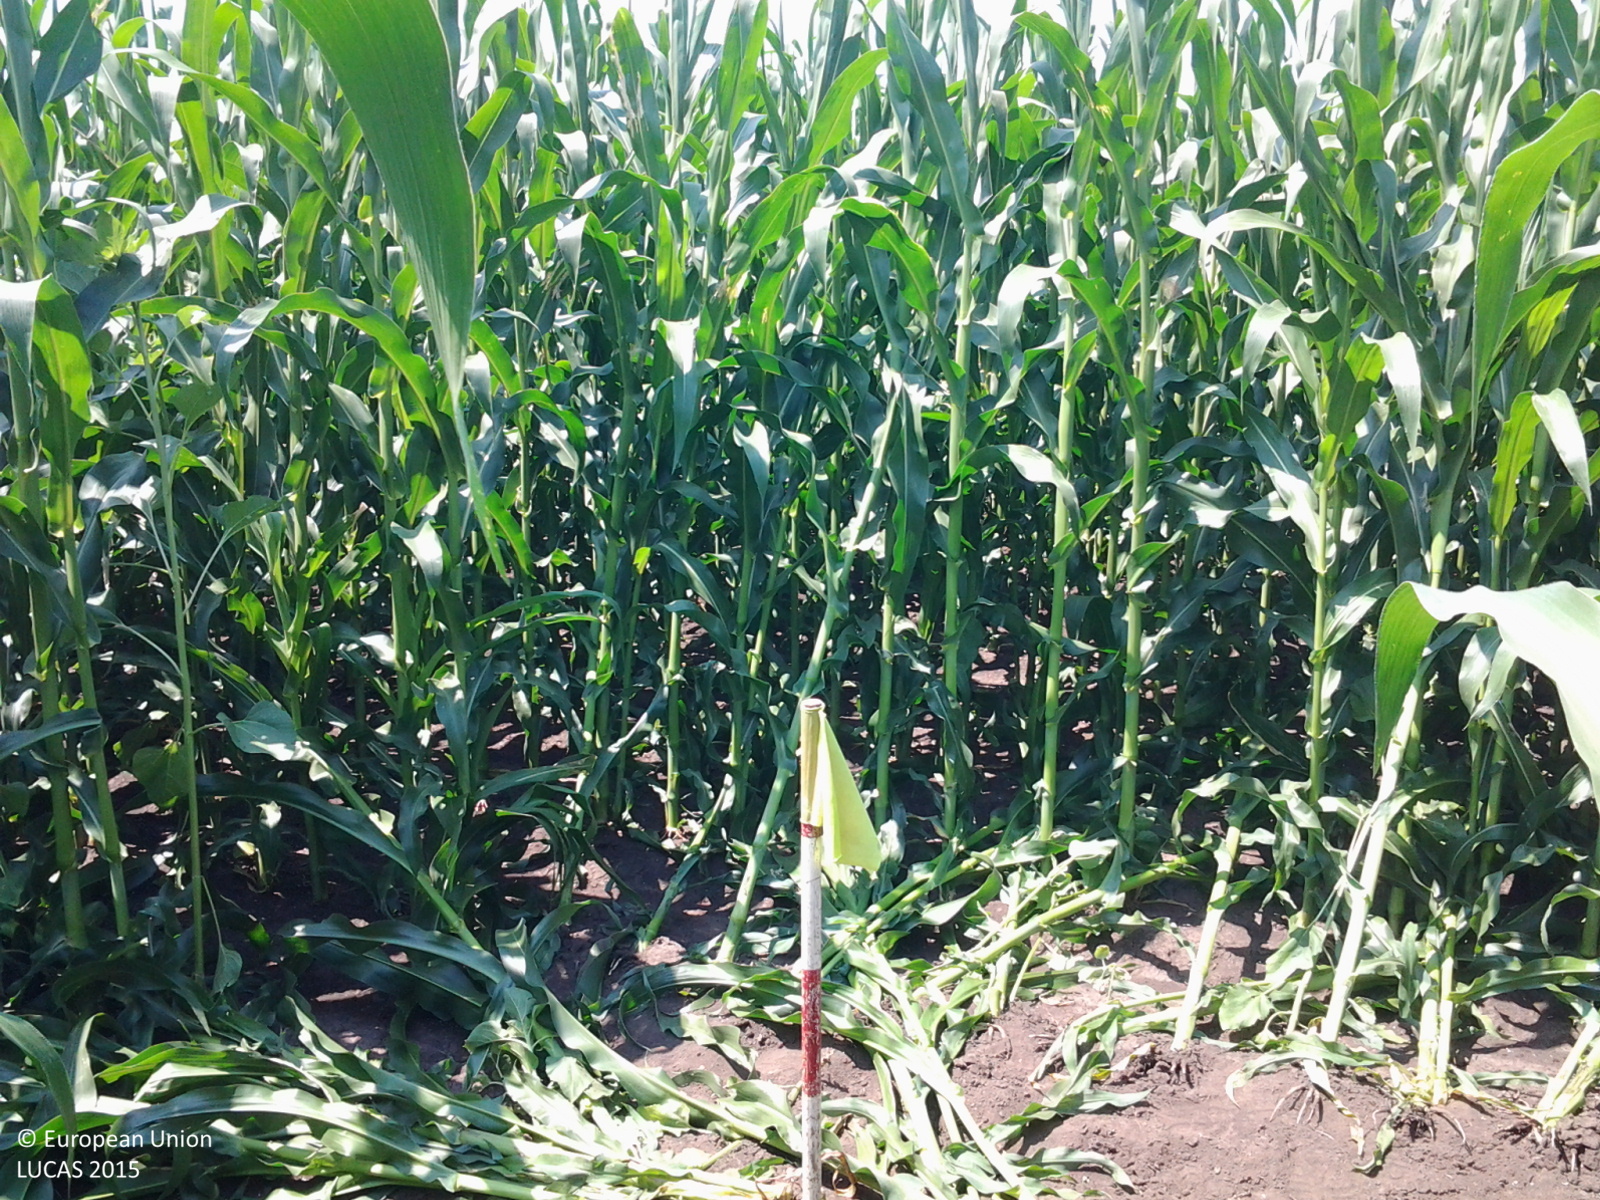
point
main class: Cropland
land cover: Maize
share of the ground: > 75 %
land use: Agriculture (excluding fallow land and kitchen gardens)
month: July
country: HU
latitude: 47.5285
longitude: 19.8403
